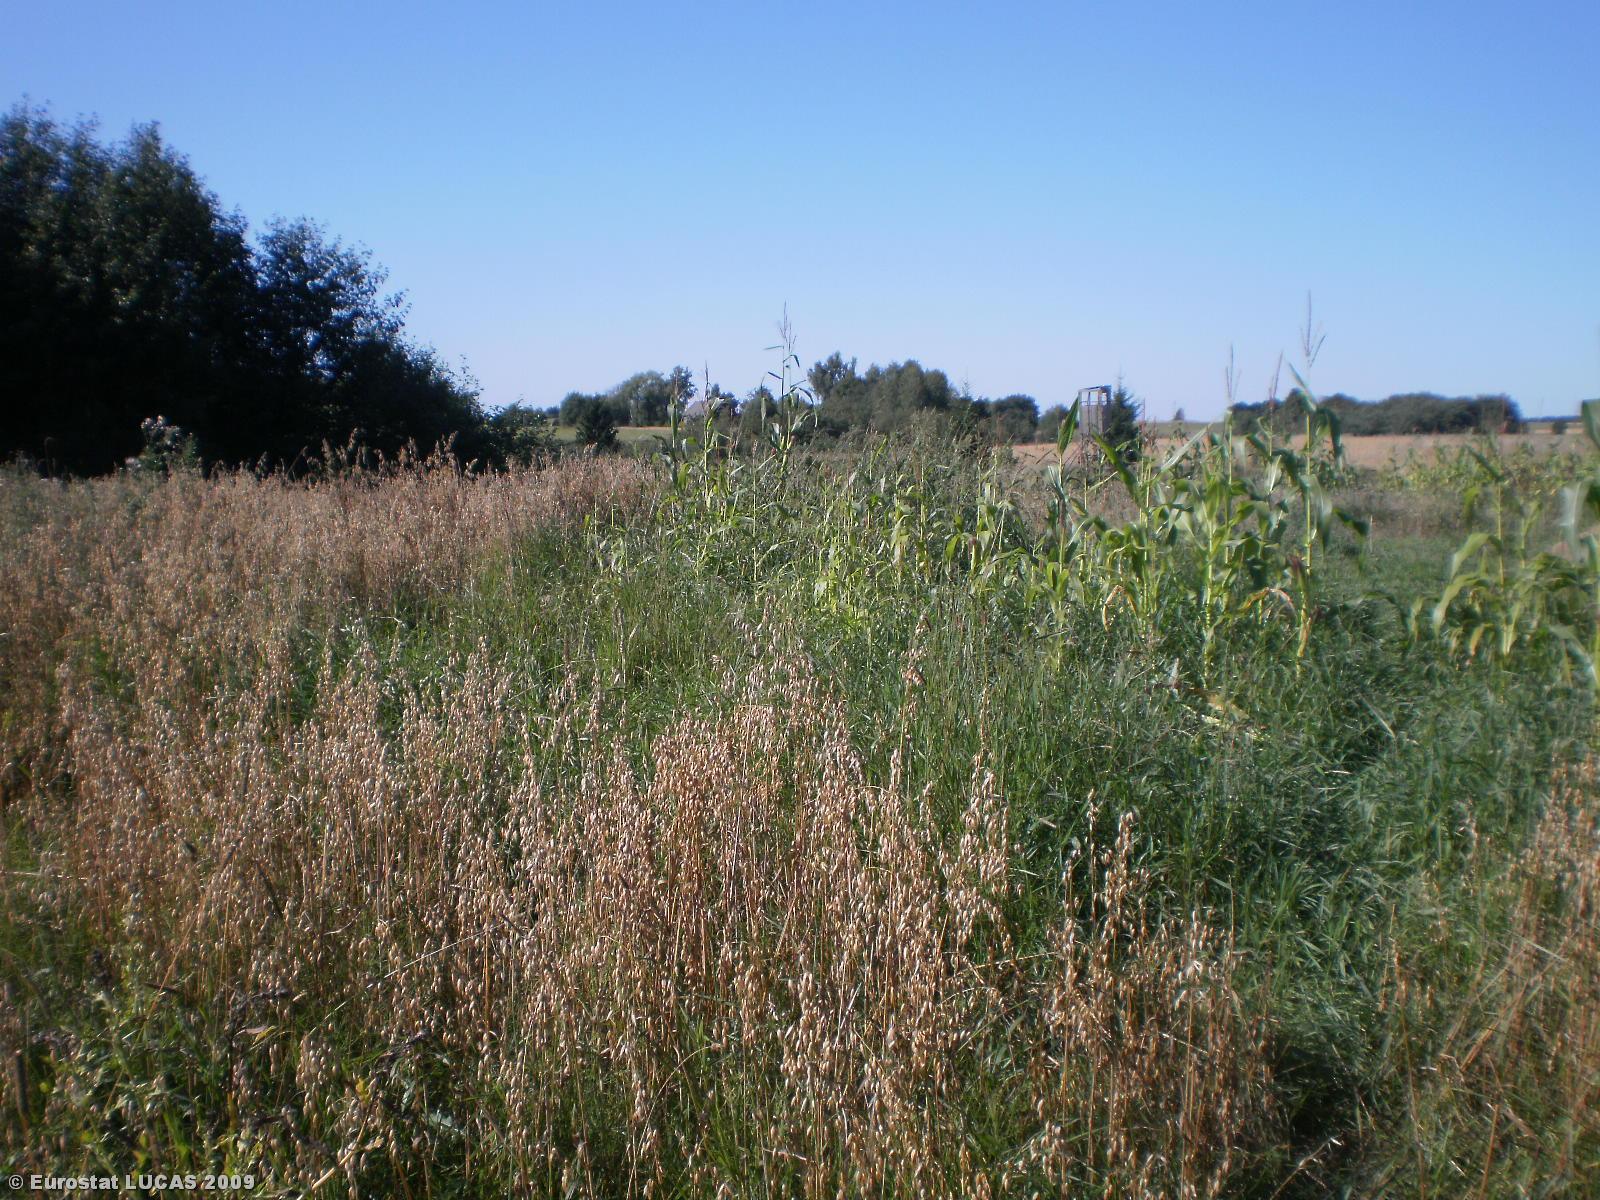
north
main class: Cropland
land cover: Oats
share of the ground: > 75 %
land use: Agriculture (excluding fallow land and kitchen gardens)
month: August
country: LT
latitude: 54.9070
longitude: 24.7533
